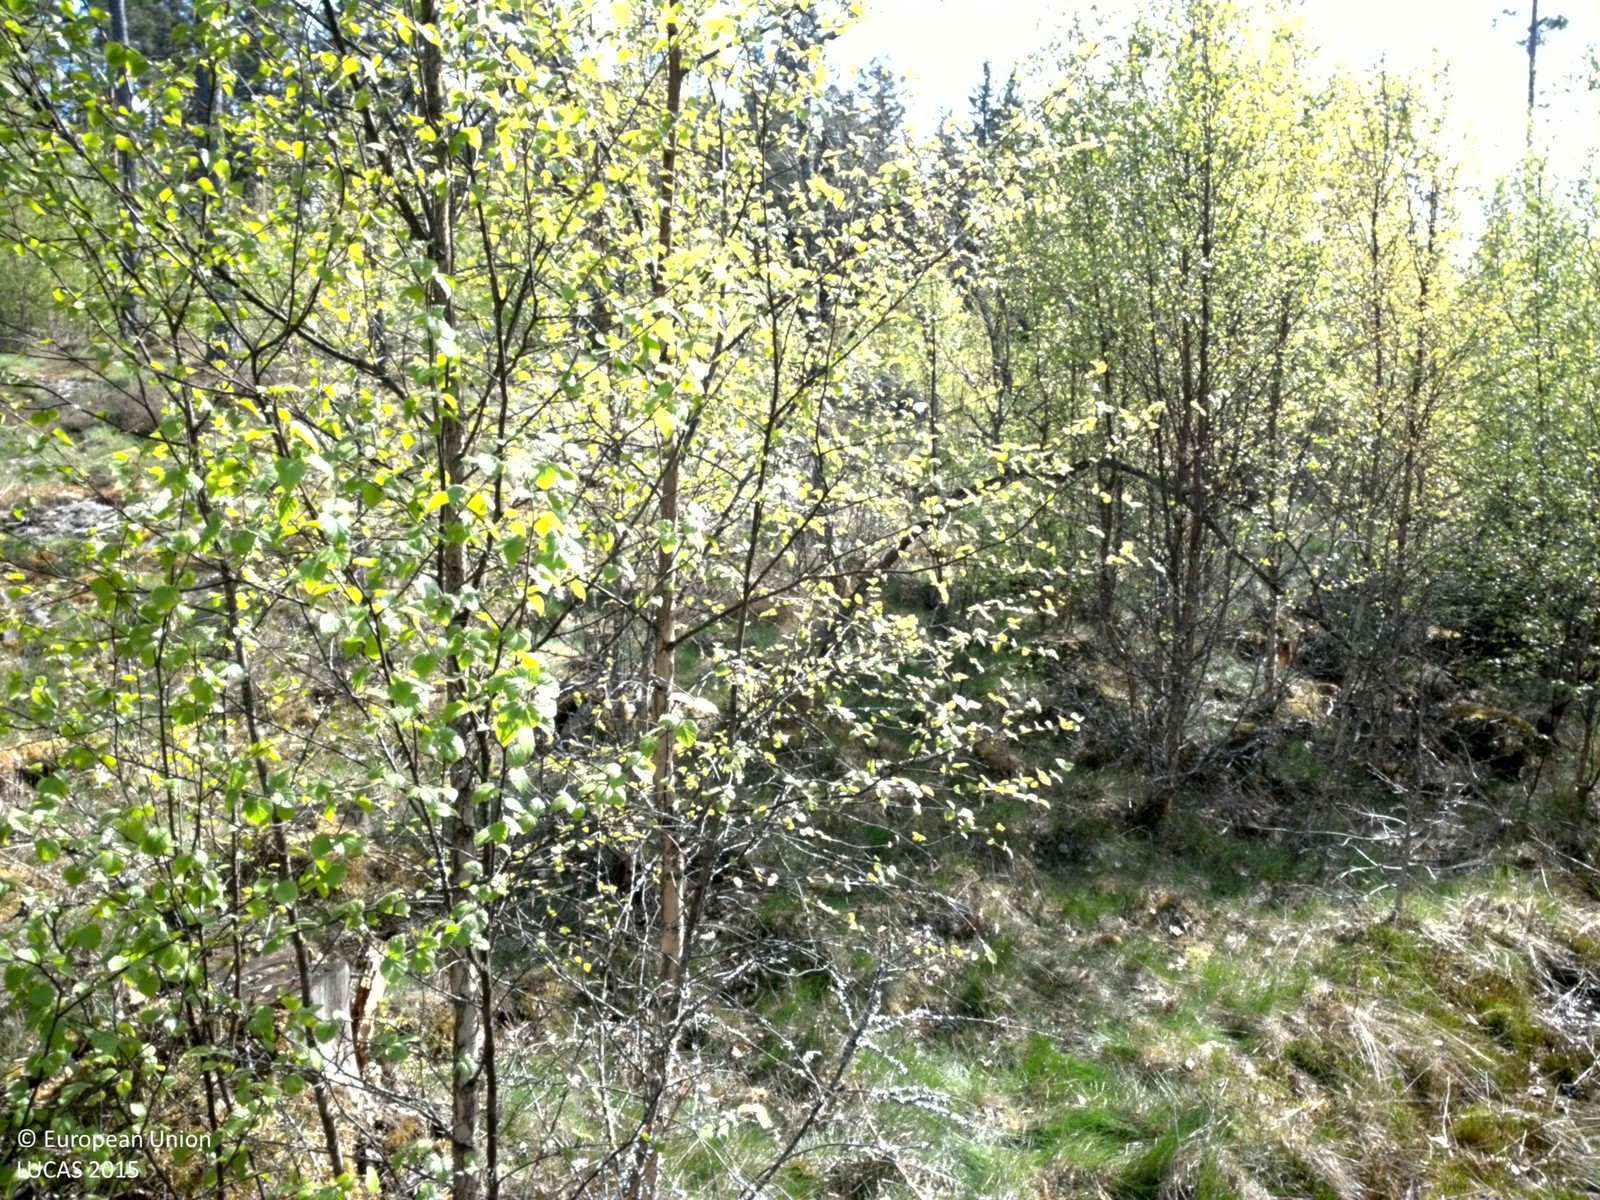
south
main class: Woodland
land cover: Broadleaved woodland
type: boreal forest
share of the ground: > 75 %
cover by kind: broadleaved forest trees 80 %, herbaceous plants 15 %, coniferous forest trees 5 %
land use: Forestry
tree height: > 5 m
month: May
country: SE
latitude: 56.4701
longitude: 15.8273
